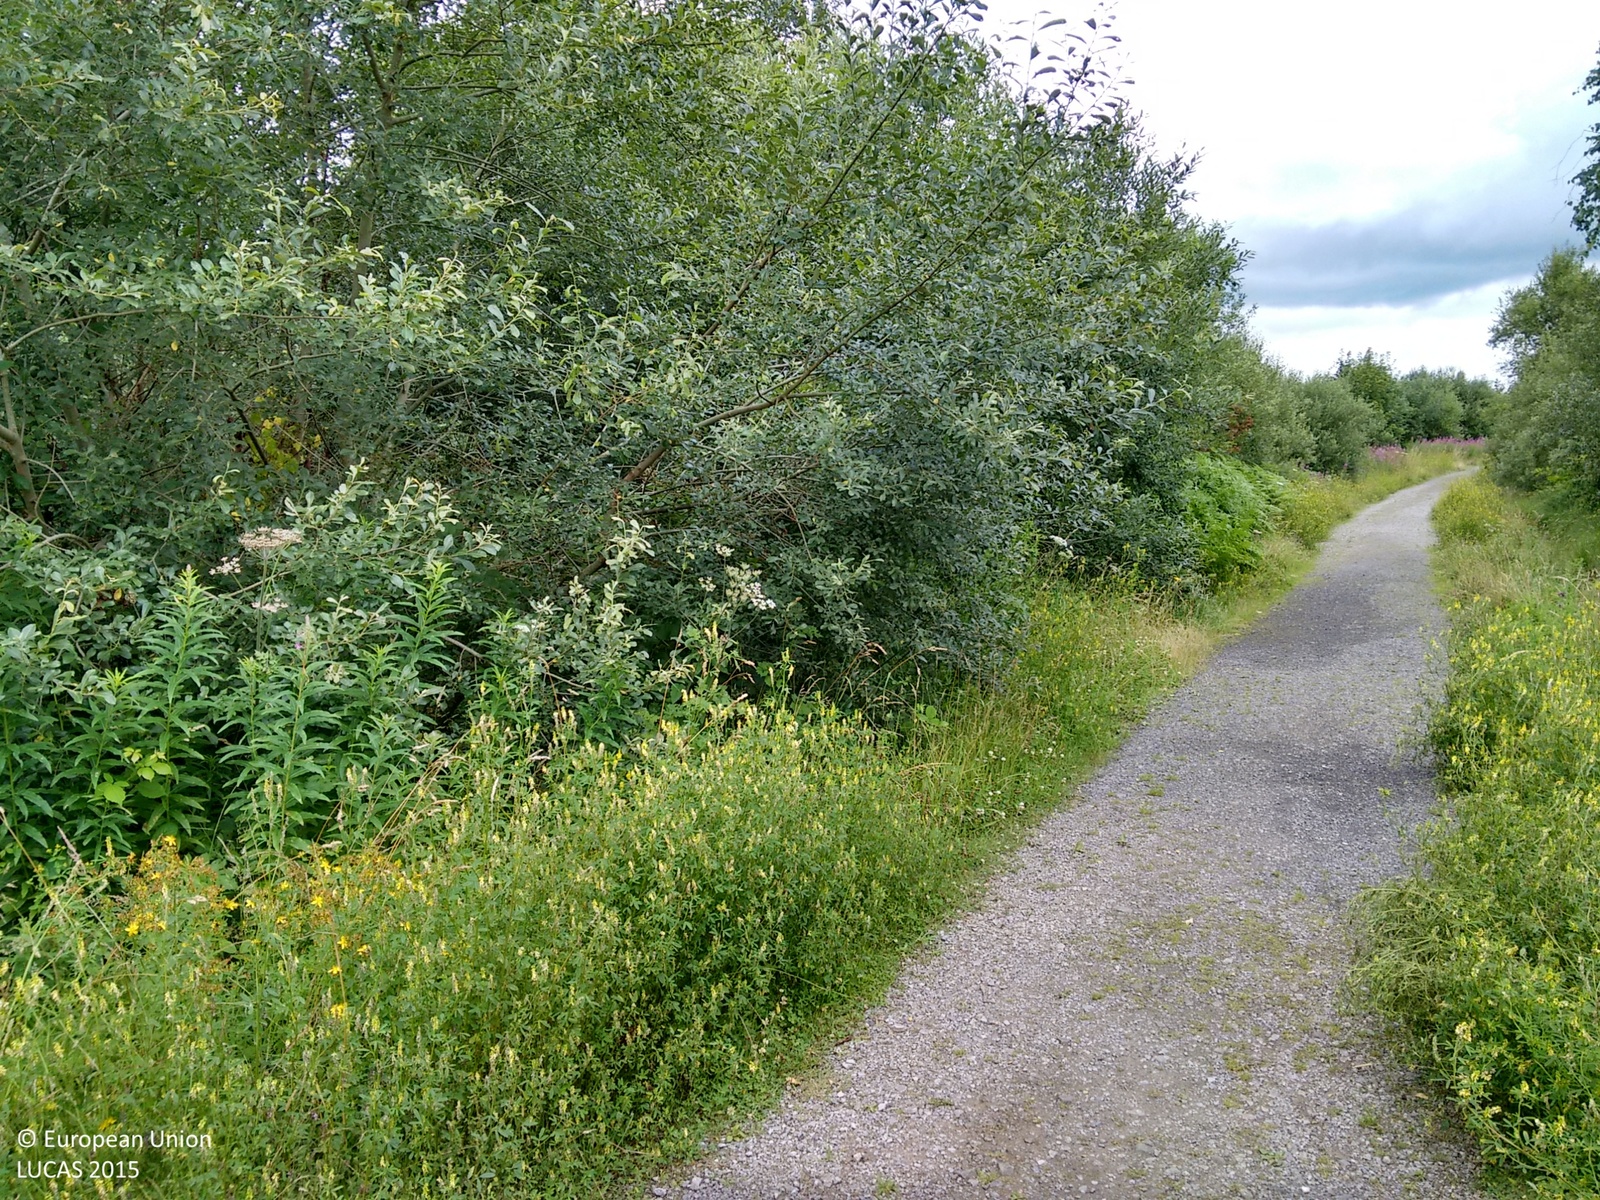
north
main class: Woodland
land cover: Broadleaved woodland
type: mesophytic deciduous forest
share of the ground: > 75 %
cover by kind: broadleaved forest trees 80 %, shrubs 20 %
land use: Forestry
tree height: > 5 m
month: July
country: GB
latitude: 51.6889
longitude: -3.9959
